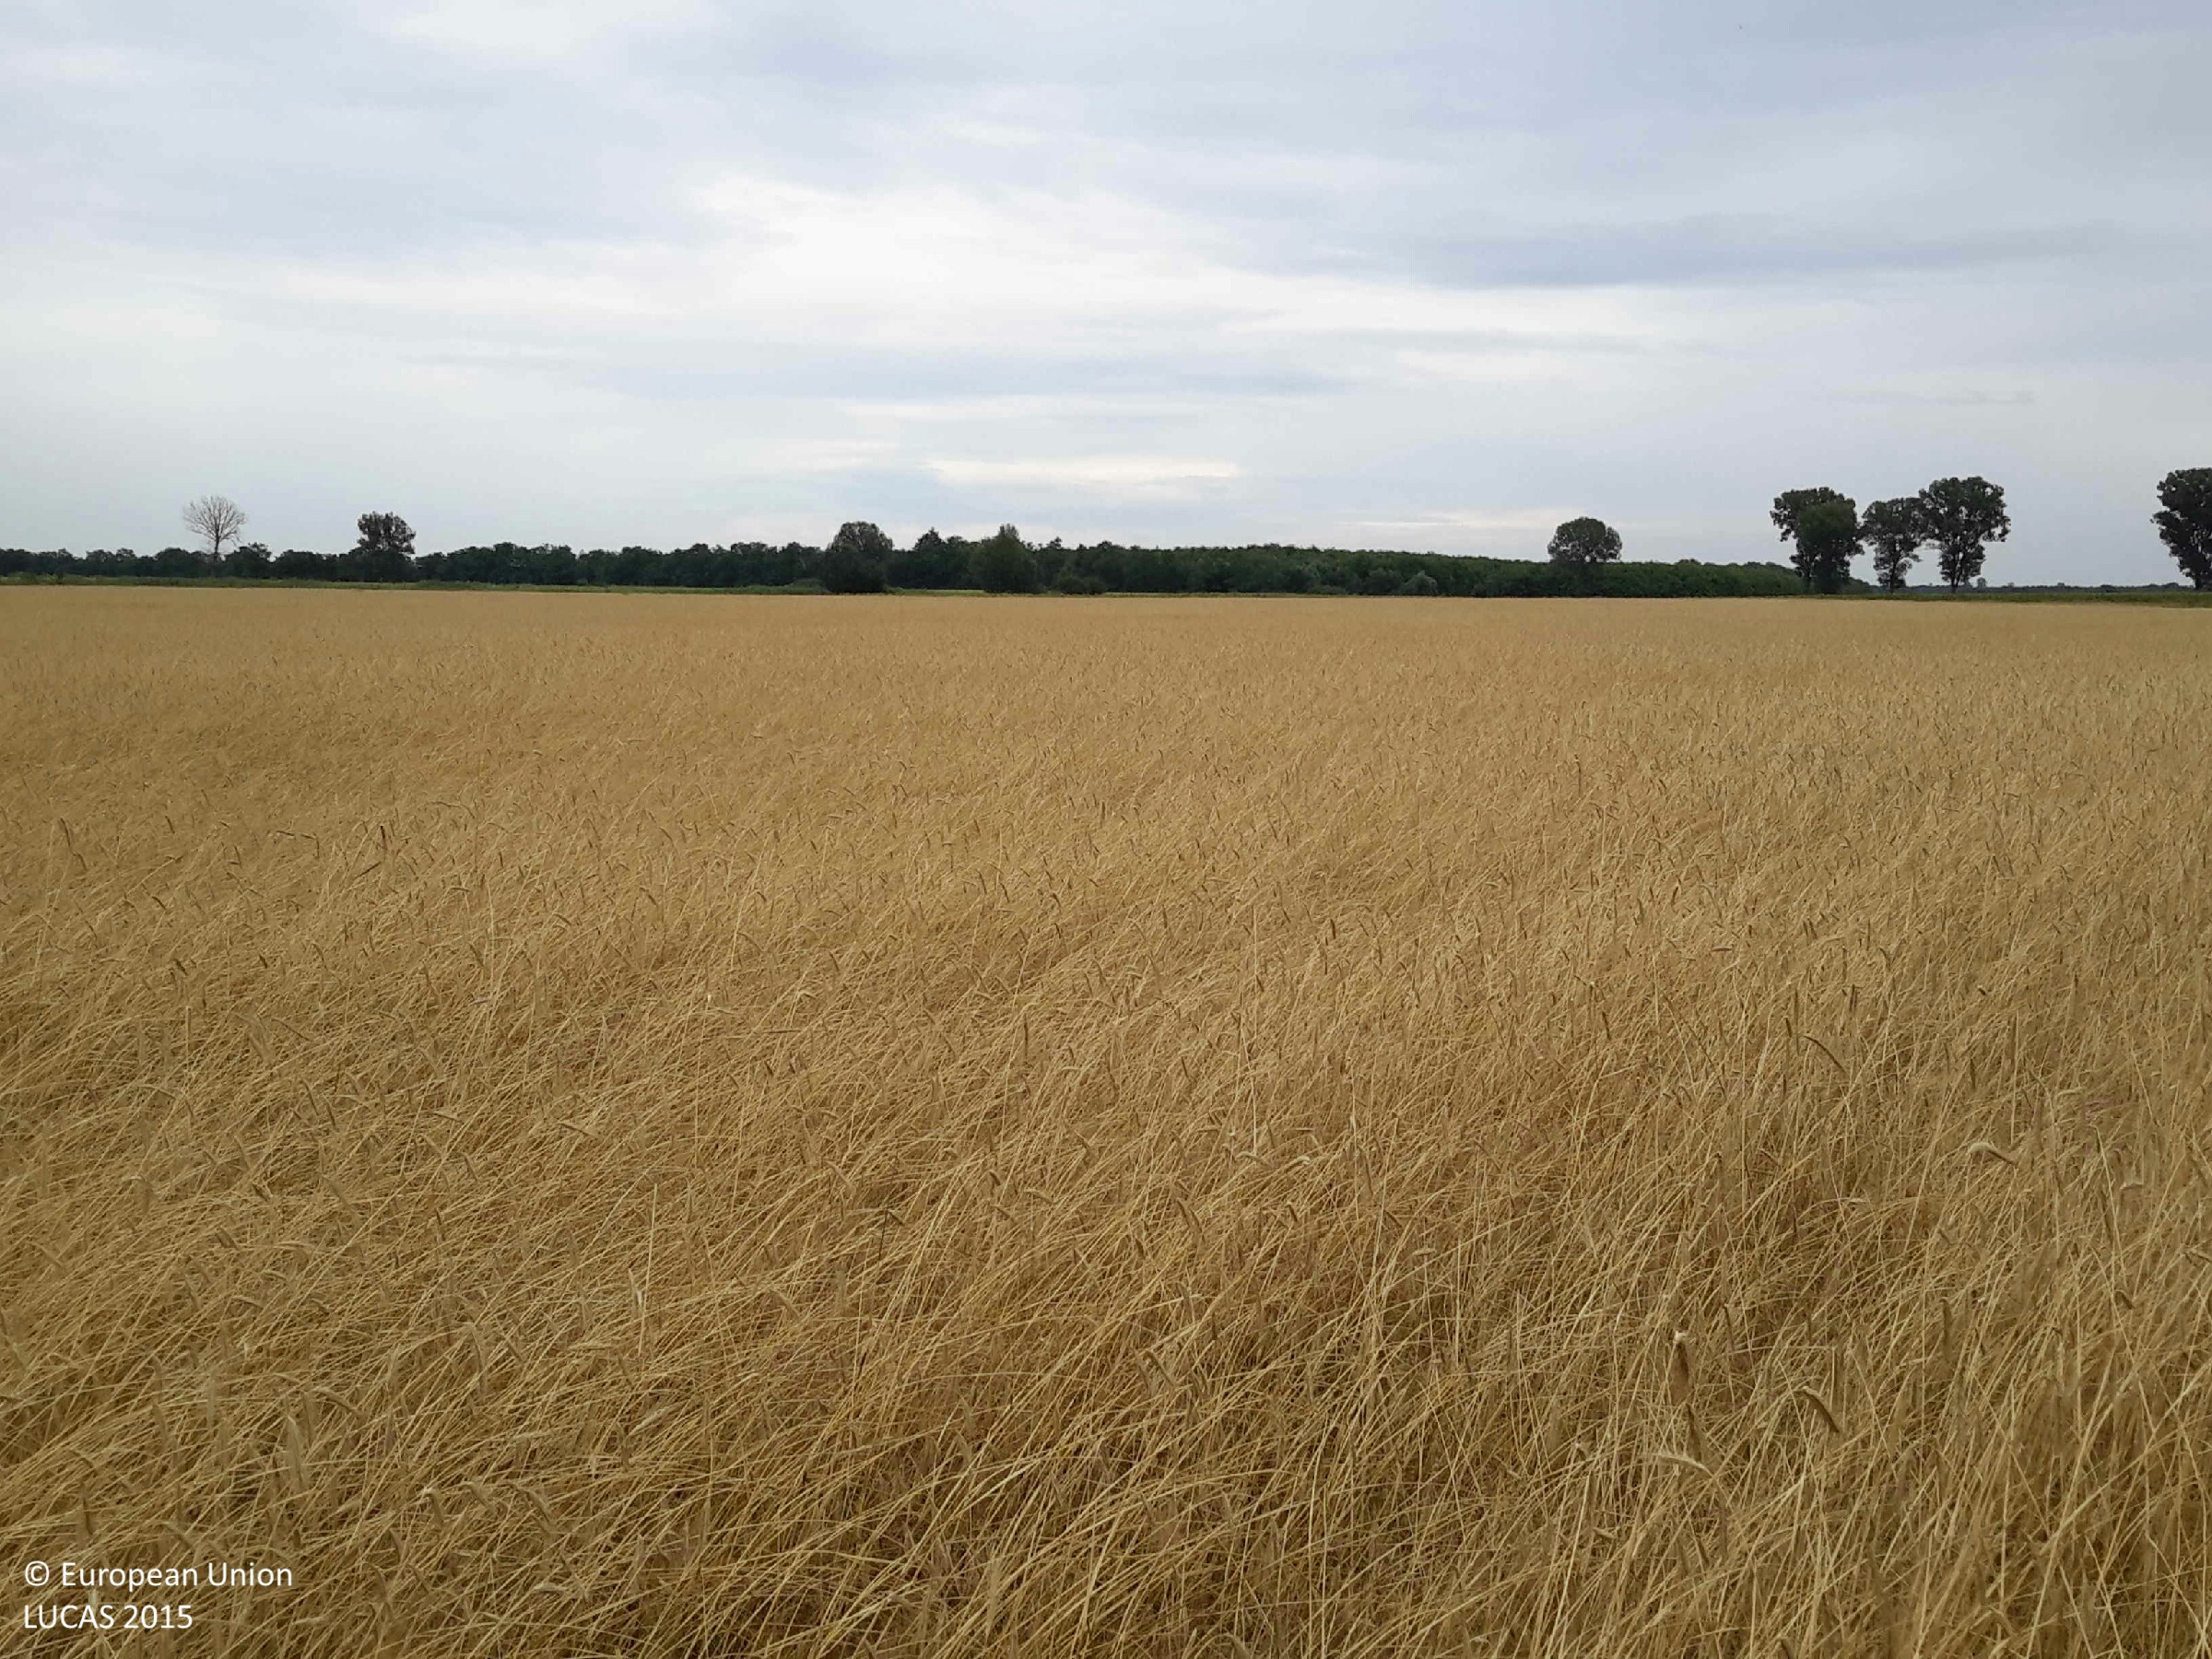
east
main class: Cropland
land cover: Barley
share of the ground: > 75 %
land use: Agriculture (excluding fallow land and kitchen gardens)
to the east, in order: Barley
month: July
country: HU
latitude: 47.4276
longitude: 17.4714
